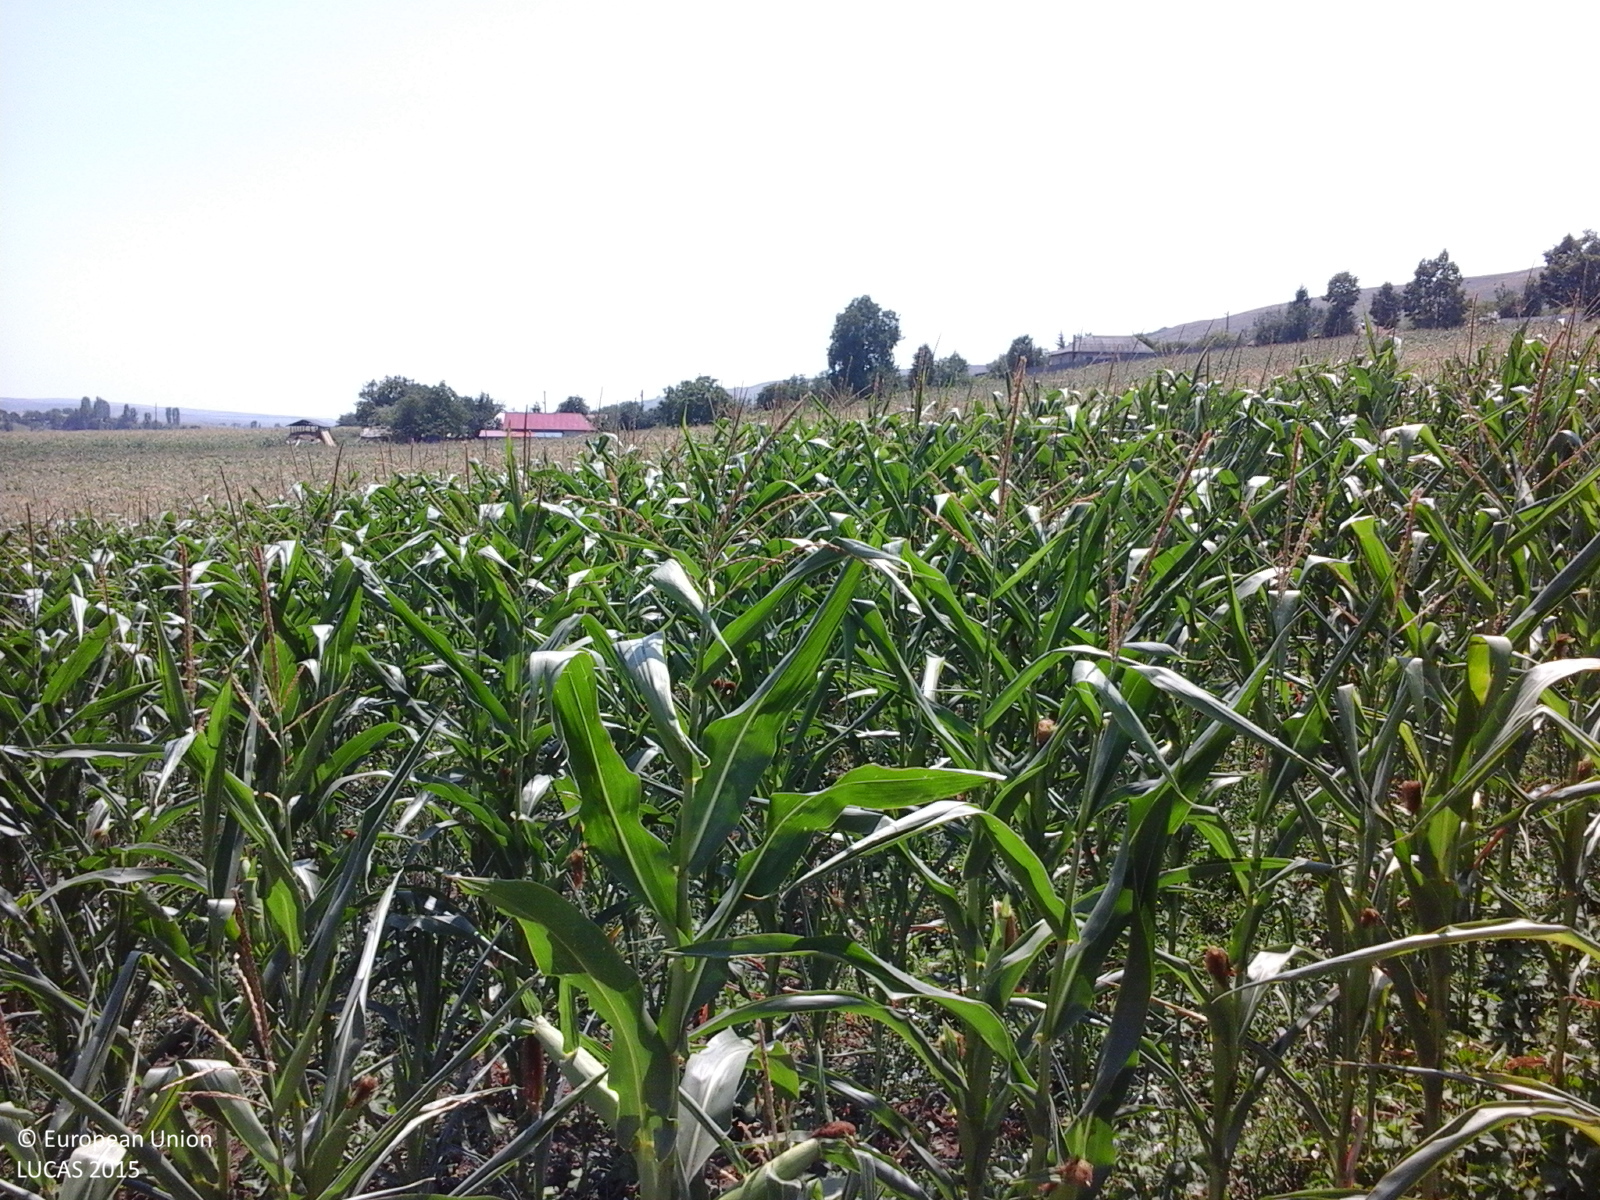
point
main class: Cropland
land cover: Maize
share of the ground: > 75 %
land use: Agriculture (excluding fallow land and kitchen gardens)
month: July
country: RO
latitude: 46.2718
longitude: 27.2961
